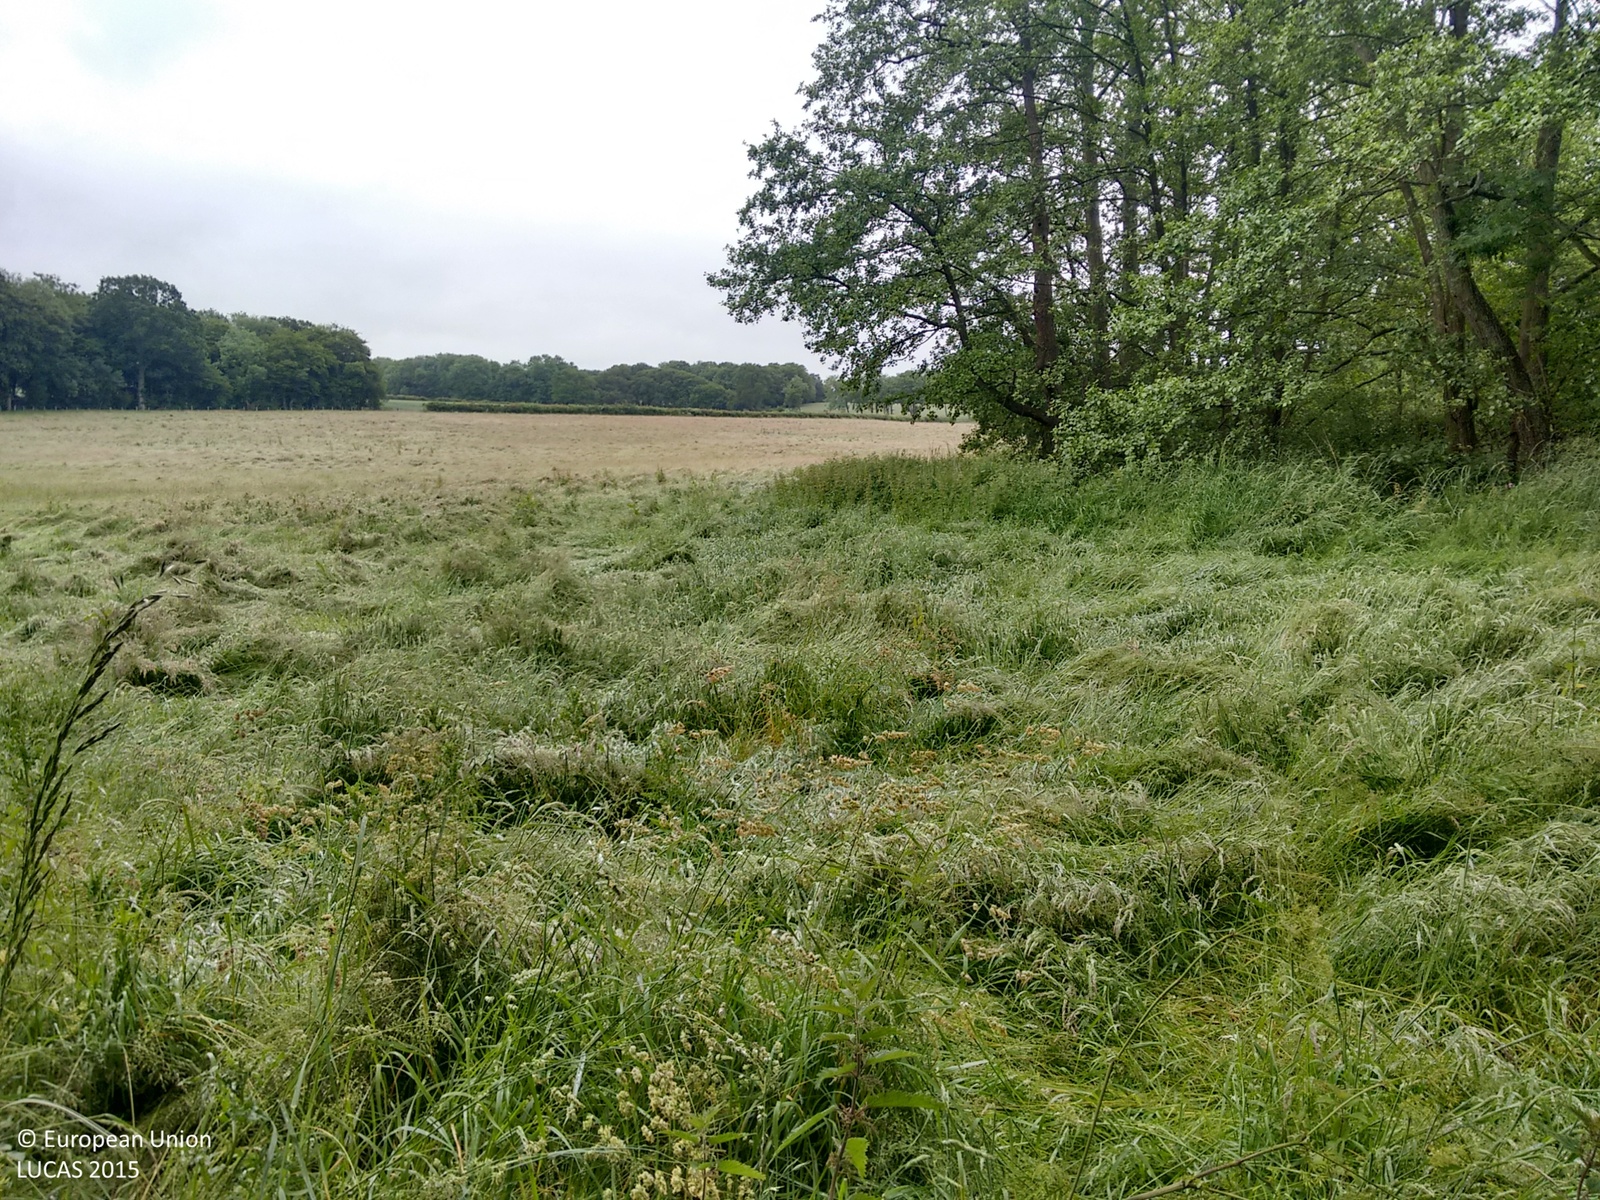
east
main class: Grassland
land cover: Grassland without tree/shrub cover
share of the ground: > 75 %
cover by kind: herbaceous plants 100 %
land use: Agriculture (excluding fallow land and kitchen gardens)
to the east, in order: Lines of trees; Grassland without tree/shrub cover
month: June
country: GB
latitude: 51.0235
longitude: 0.3473
